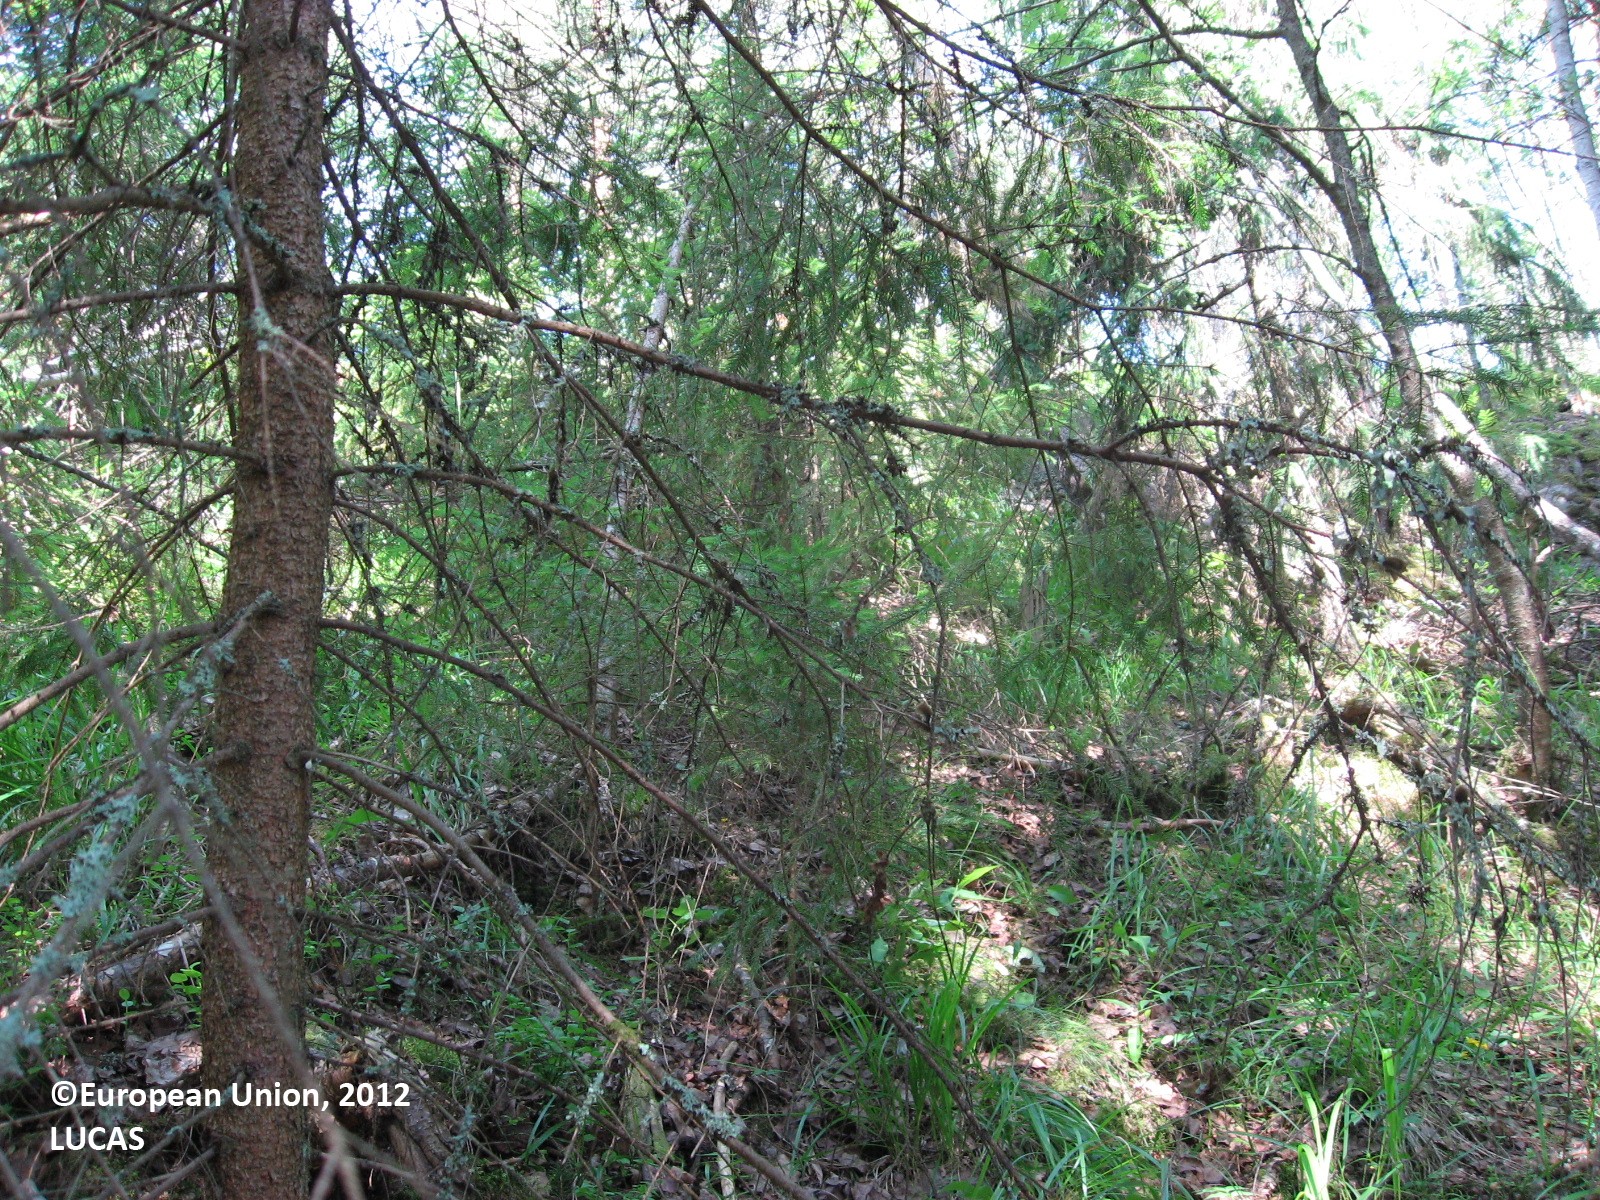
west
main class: Woodland
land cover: Spruce dominated mixed woodland
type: boreal forest
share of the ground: > 75 %
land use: Forestry
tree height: > 5 m
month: July
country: FI
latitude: 60.8404
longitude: 26.5099
